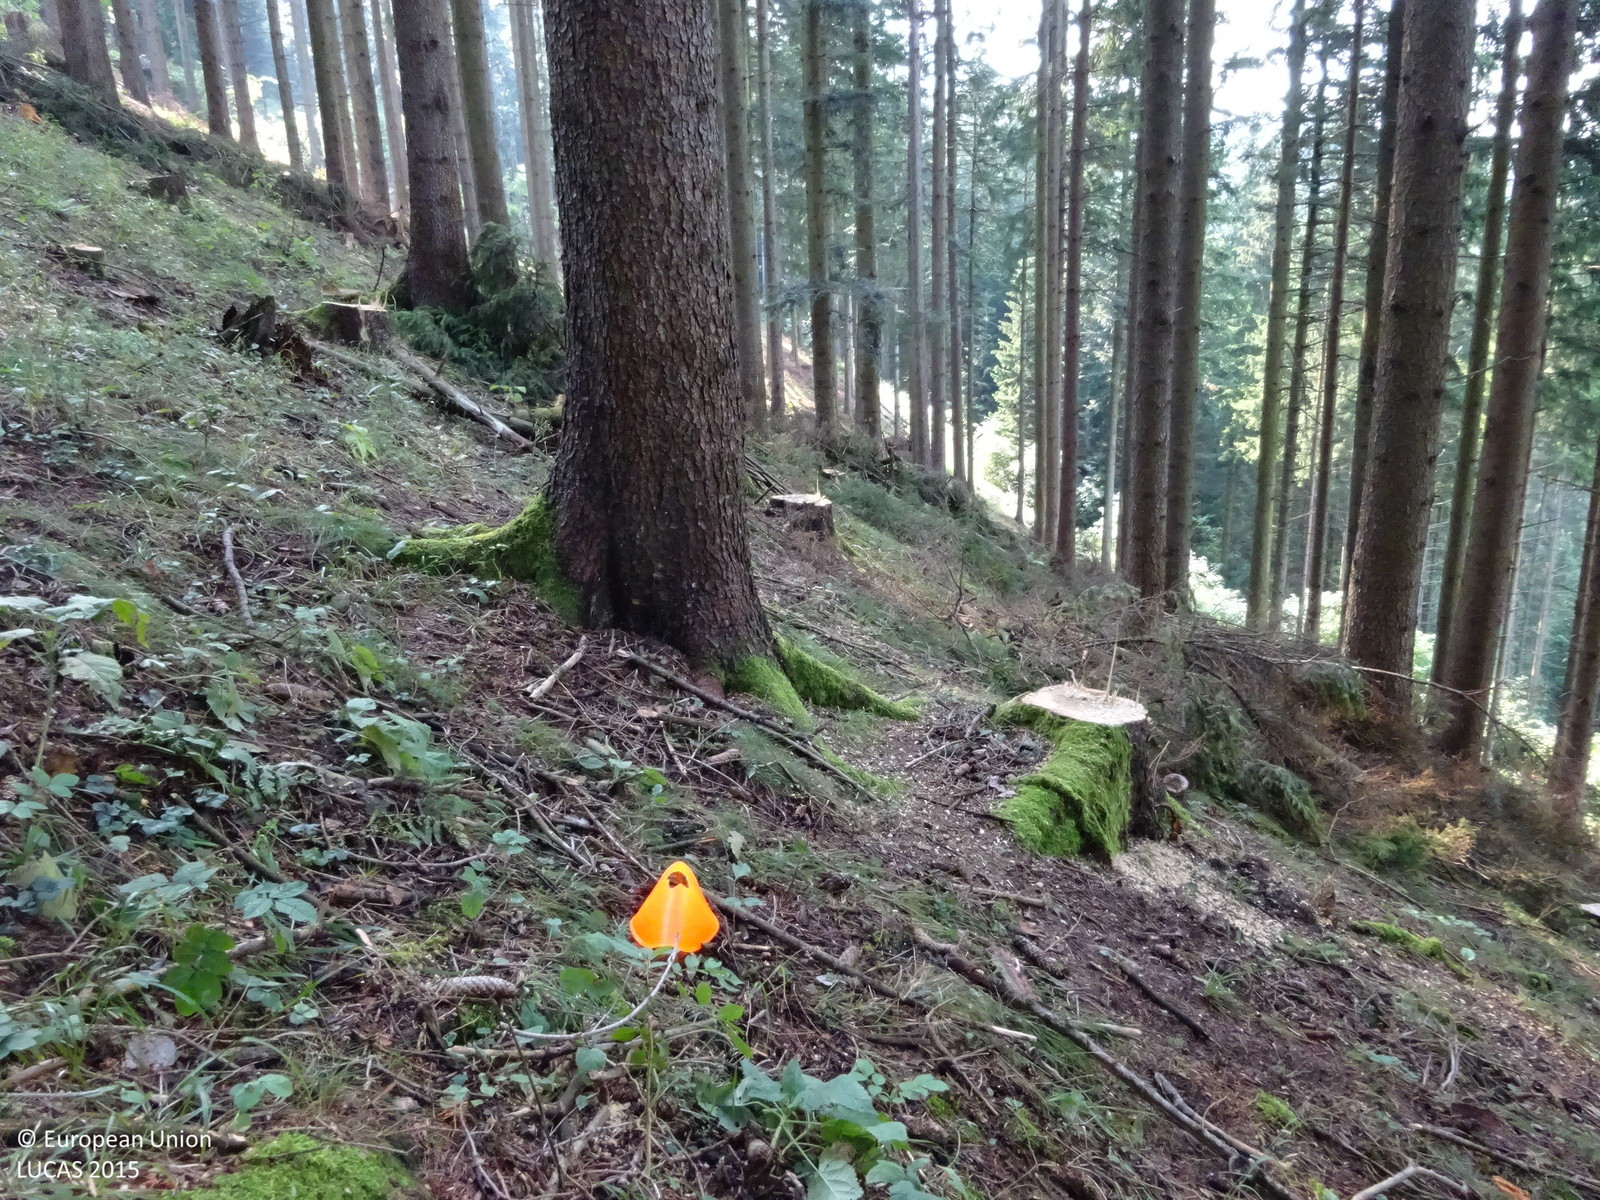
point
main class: Woodland
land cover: Spruce dominated coniferous woodland
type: alpine coniferous forest
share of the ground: > 75 %
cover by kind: coniferous forest trees 90 %, herbaceous plants 5 %, lichens and mosses 5 %
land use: Forestry
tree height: > 5 m
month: August
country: AT
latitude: 47.3375
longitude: 15.6786
